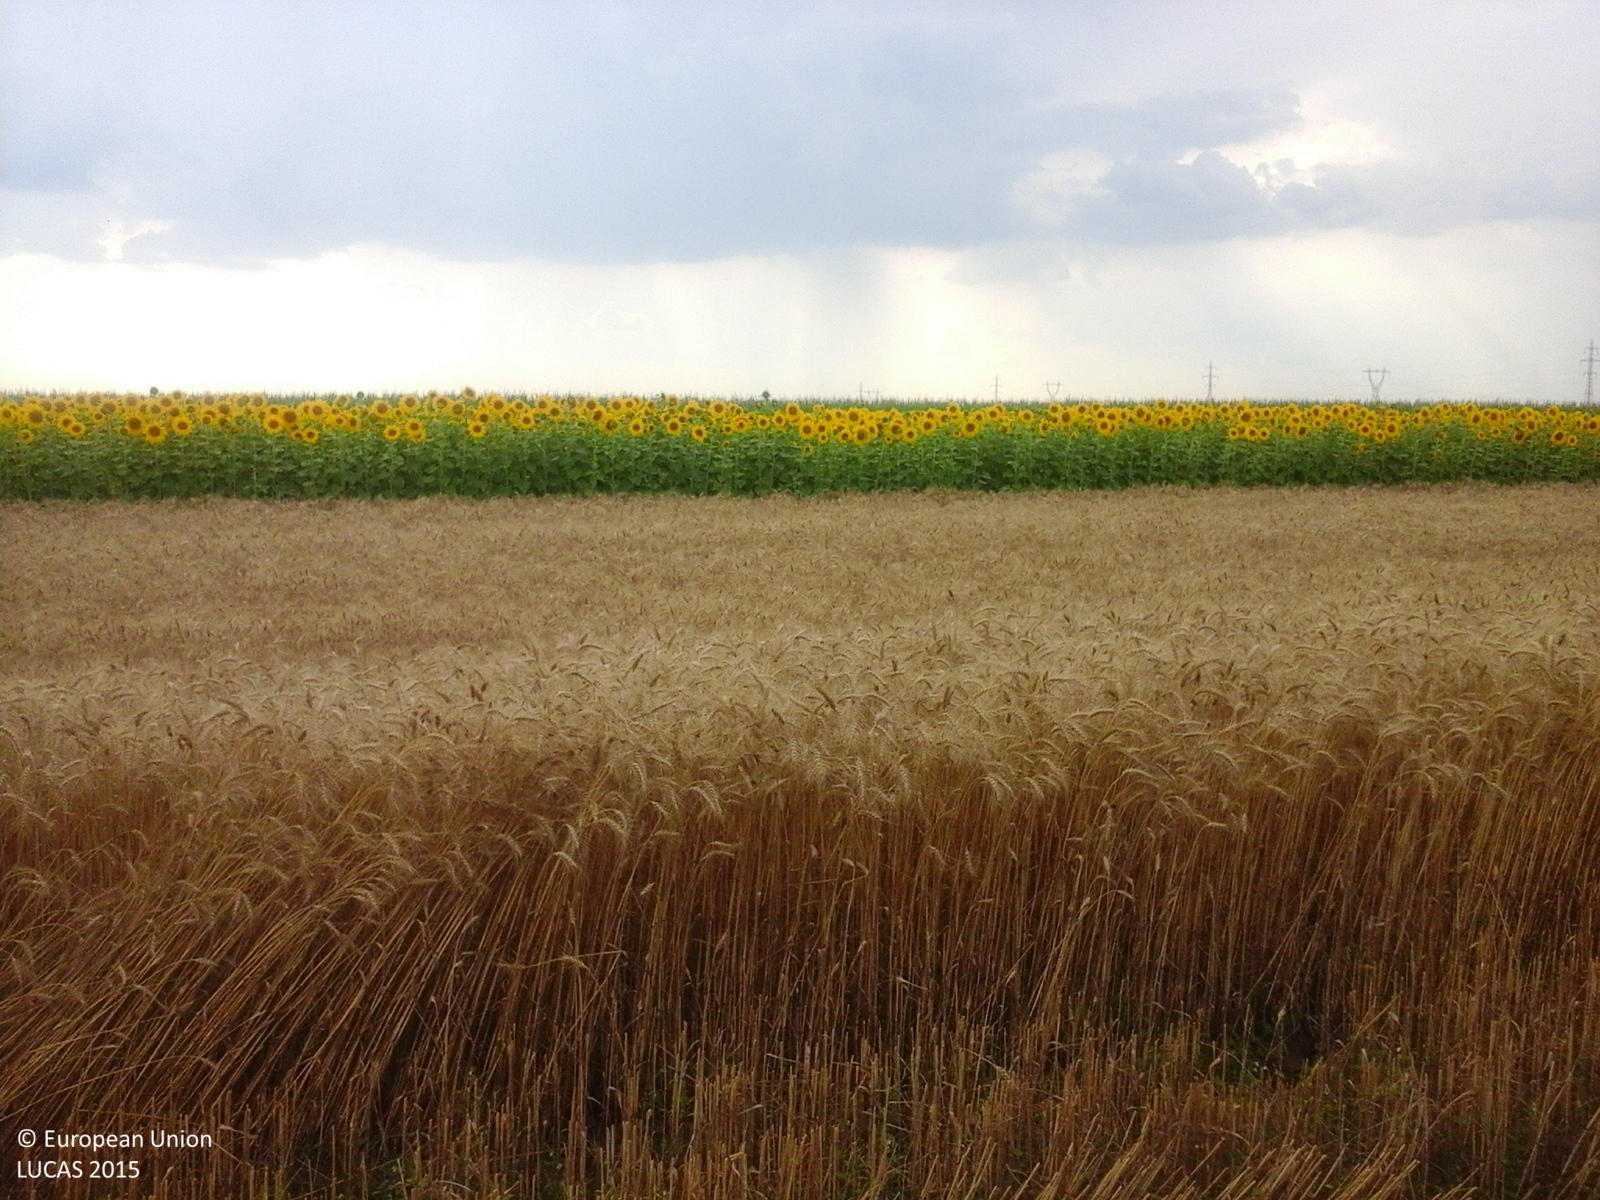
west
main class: Cropland
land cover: Common wheat
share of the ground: > 75 %
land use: Agriculture (excluding fallow land and kitchen gardens)
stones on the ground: < 10 %
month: July
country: RO
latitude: 43.9317
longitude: 25.7241
